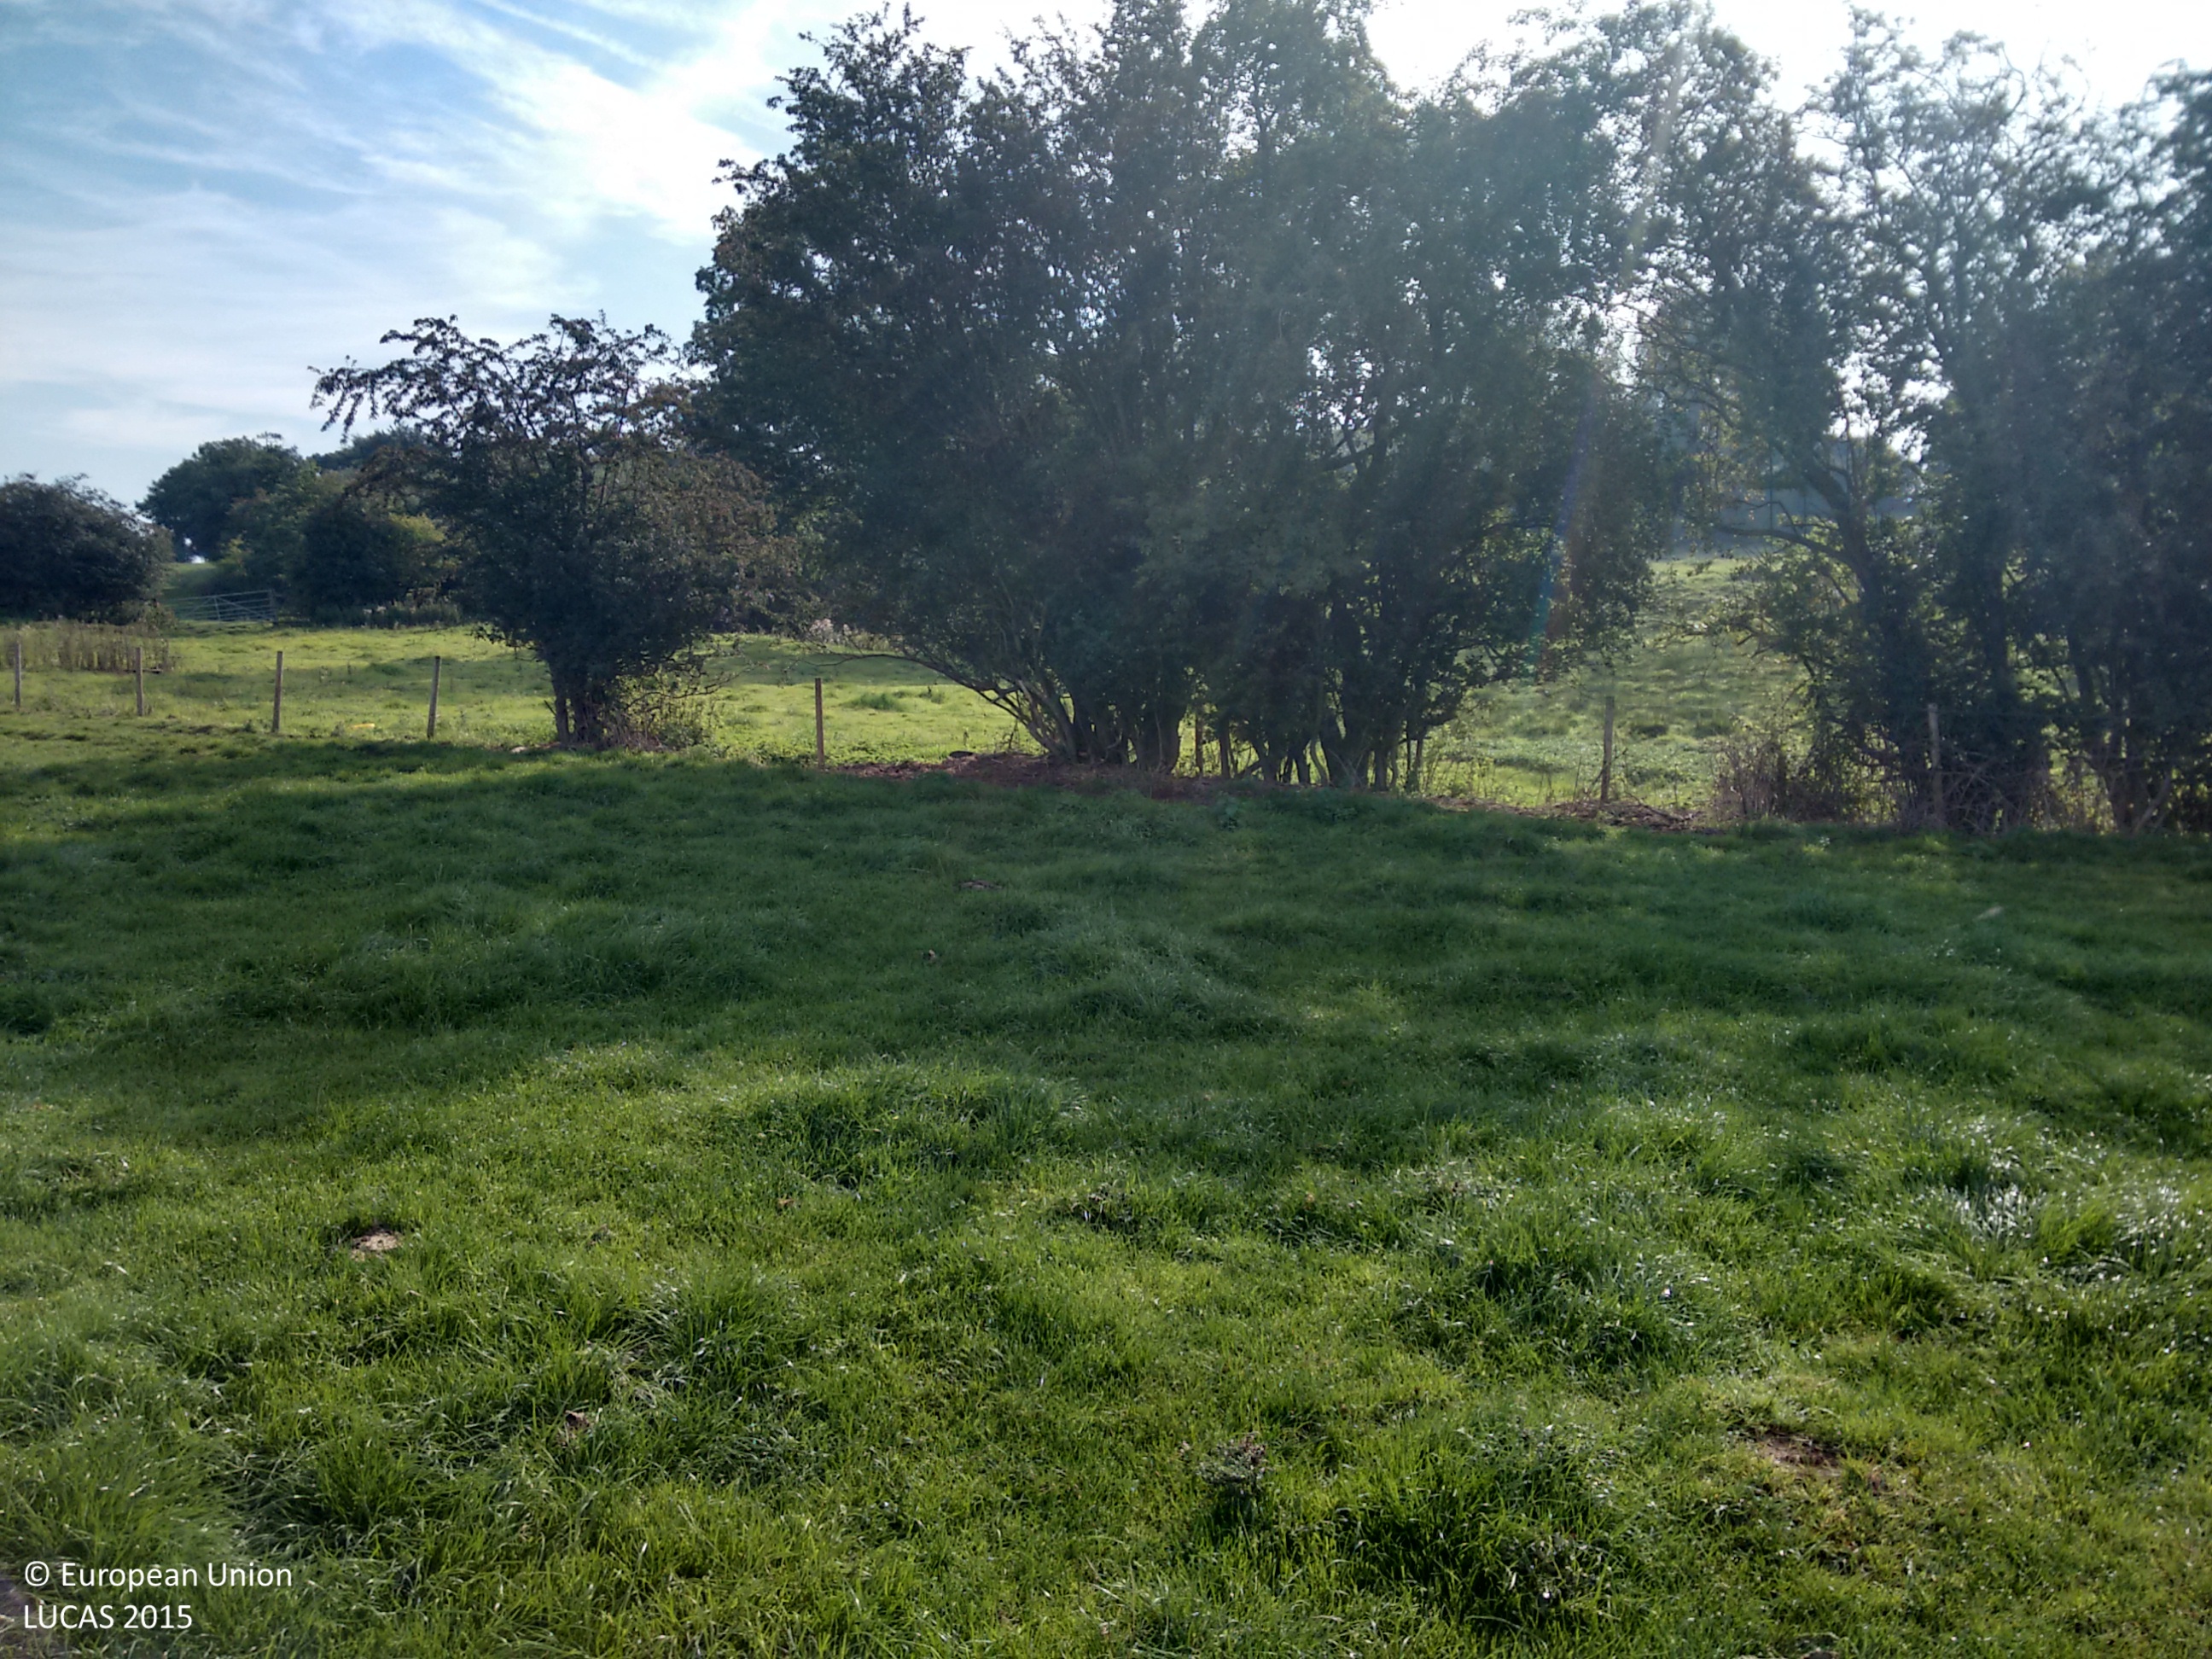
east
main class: Grassland
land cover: Grassland without tree/shrub cover
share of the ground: > 75 %
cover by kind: herbaceous plants 100 %
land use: Agriculture (excluding fallow land and kitchen gardens)
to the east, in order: Grassland without tree/shrub cover; Abandoned hedges; Fences; Grassland without tree/shrub cover; Managed hedges; Grassland without tree/shrub cover; Managed hedges; Grassland without tree/shrub cover; Broadleaved woodland; Other coniferous woodland; Broadleaved woodland
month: September
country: GB
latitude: 52.9863
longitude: -2.6859
